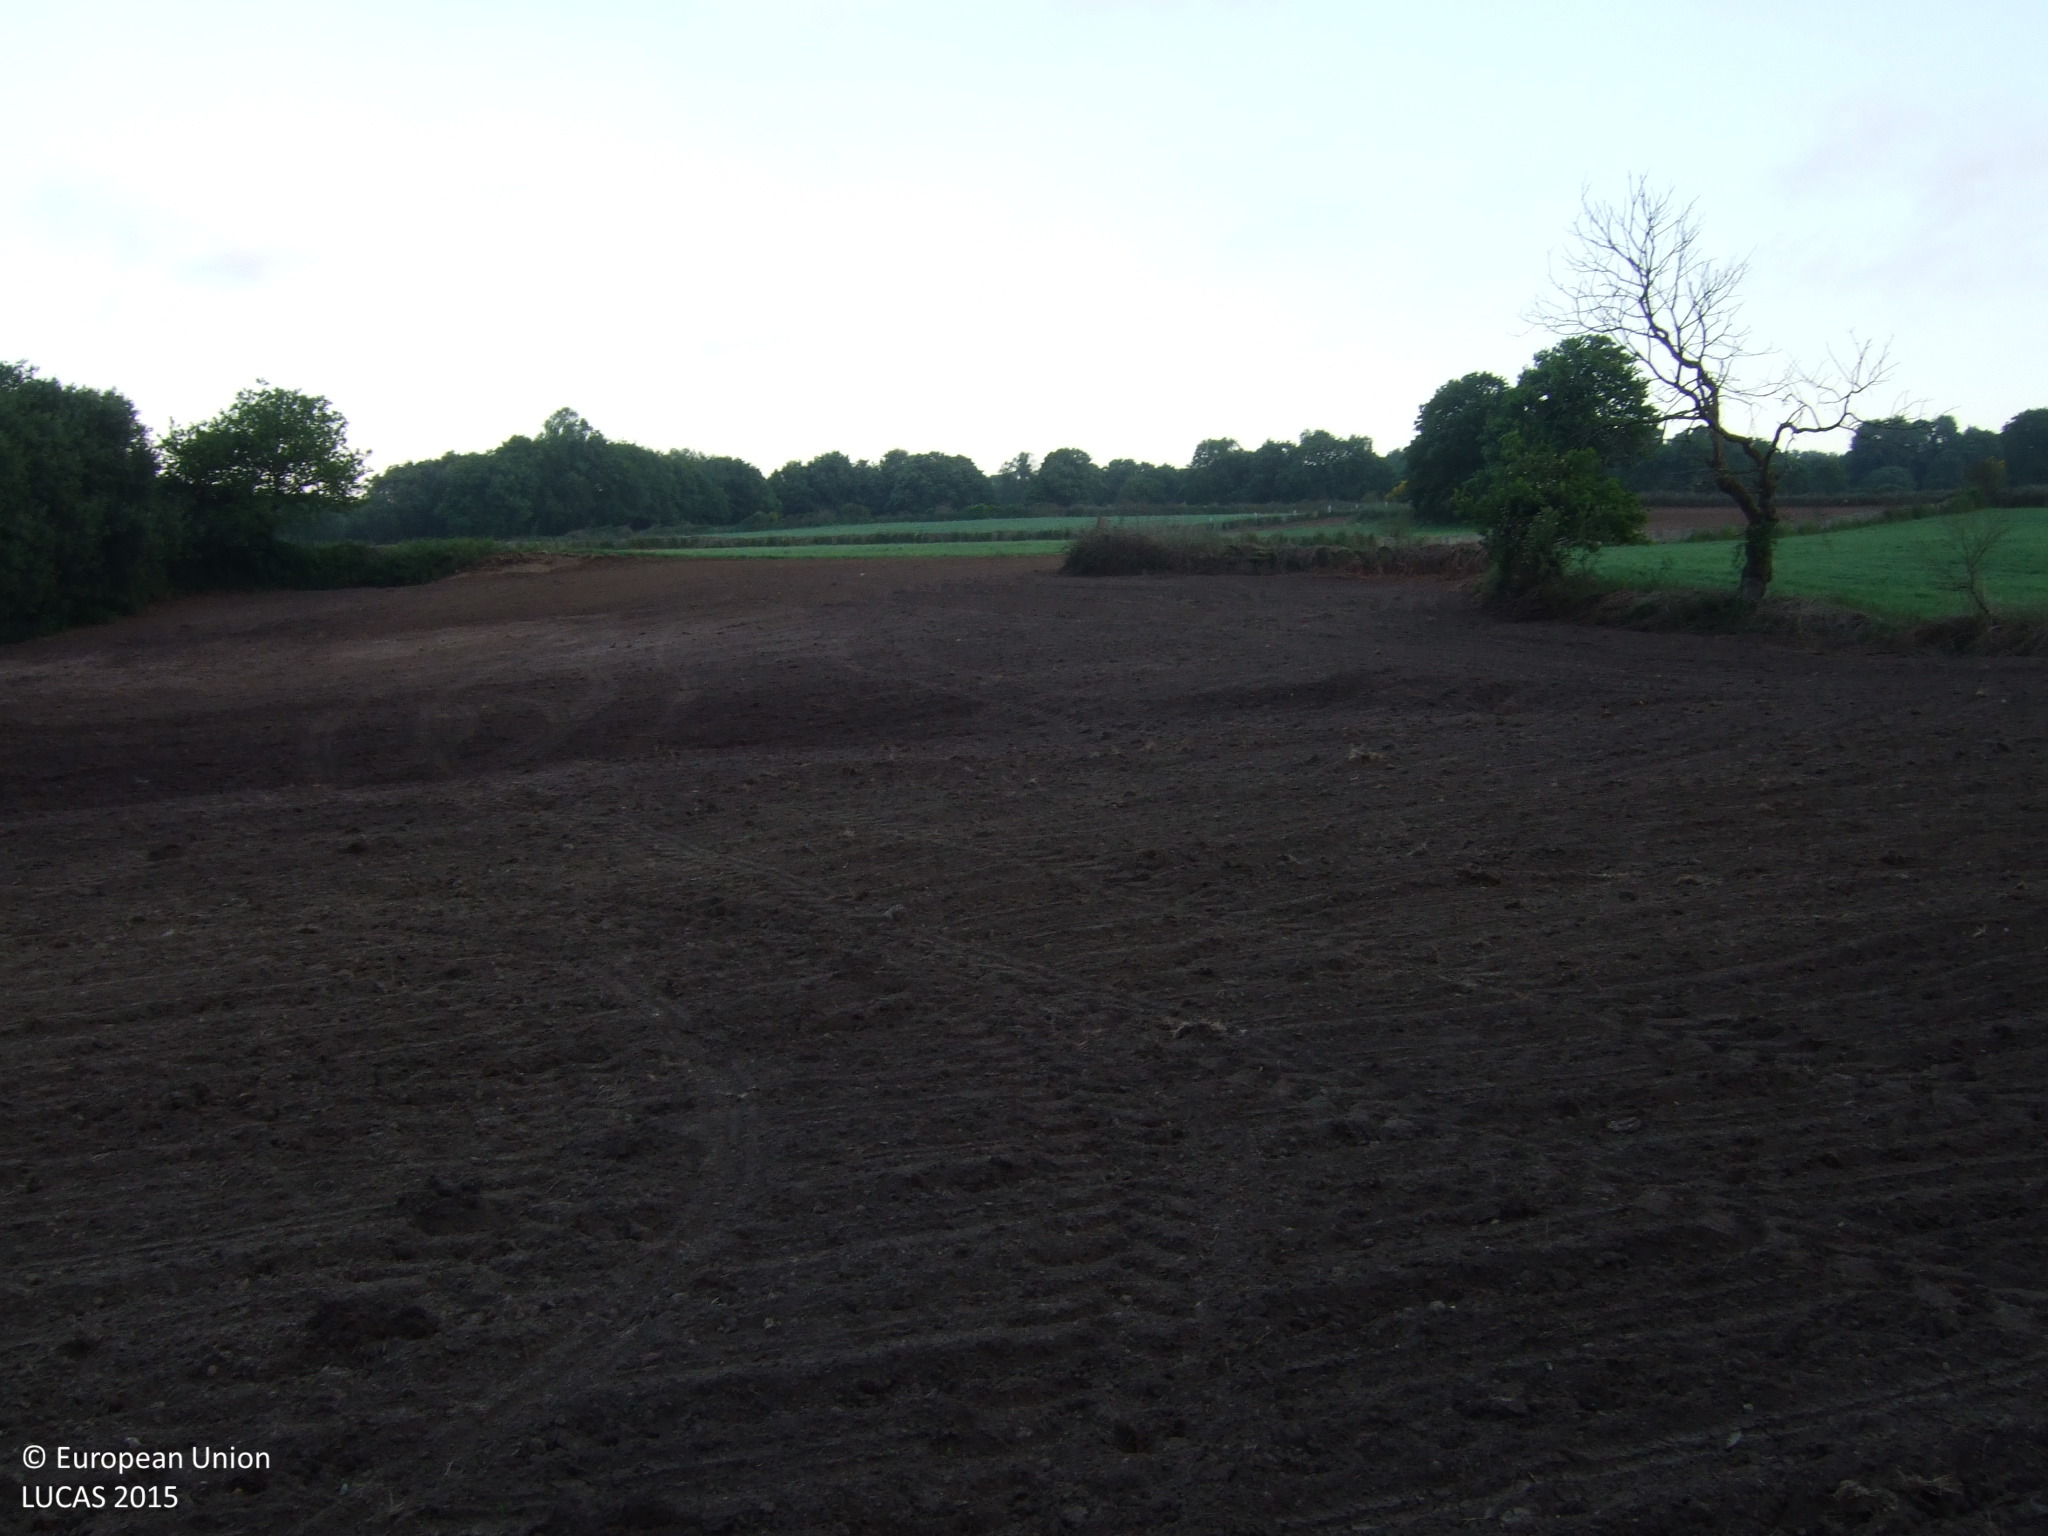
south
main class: Cropland
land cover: Maize
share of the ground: < 10 %
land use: Agriculture (excluding fallow land and kitchen gardens)
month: May
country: ES
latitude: 42.9264
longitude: -7.5852
